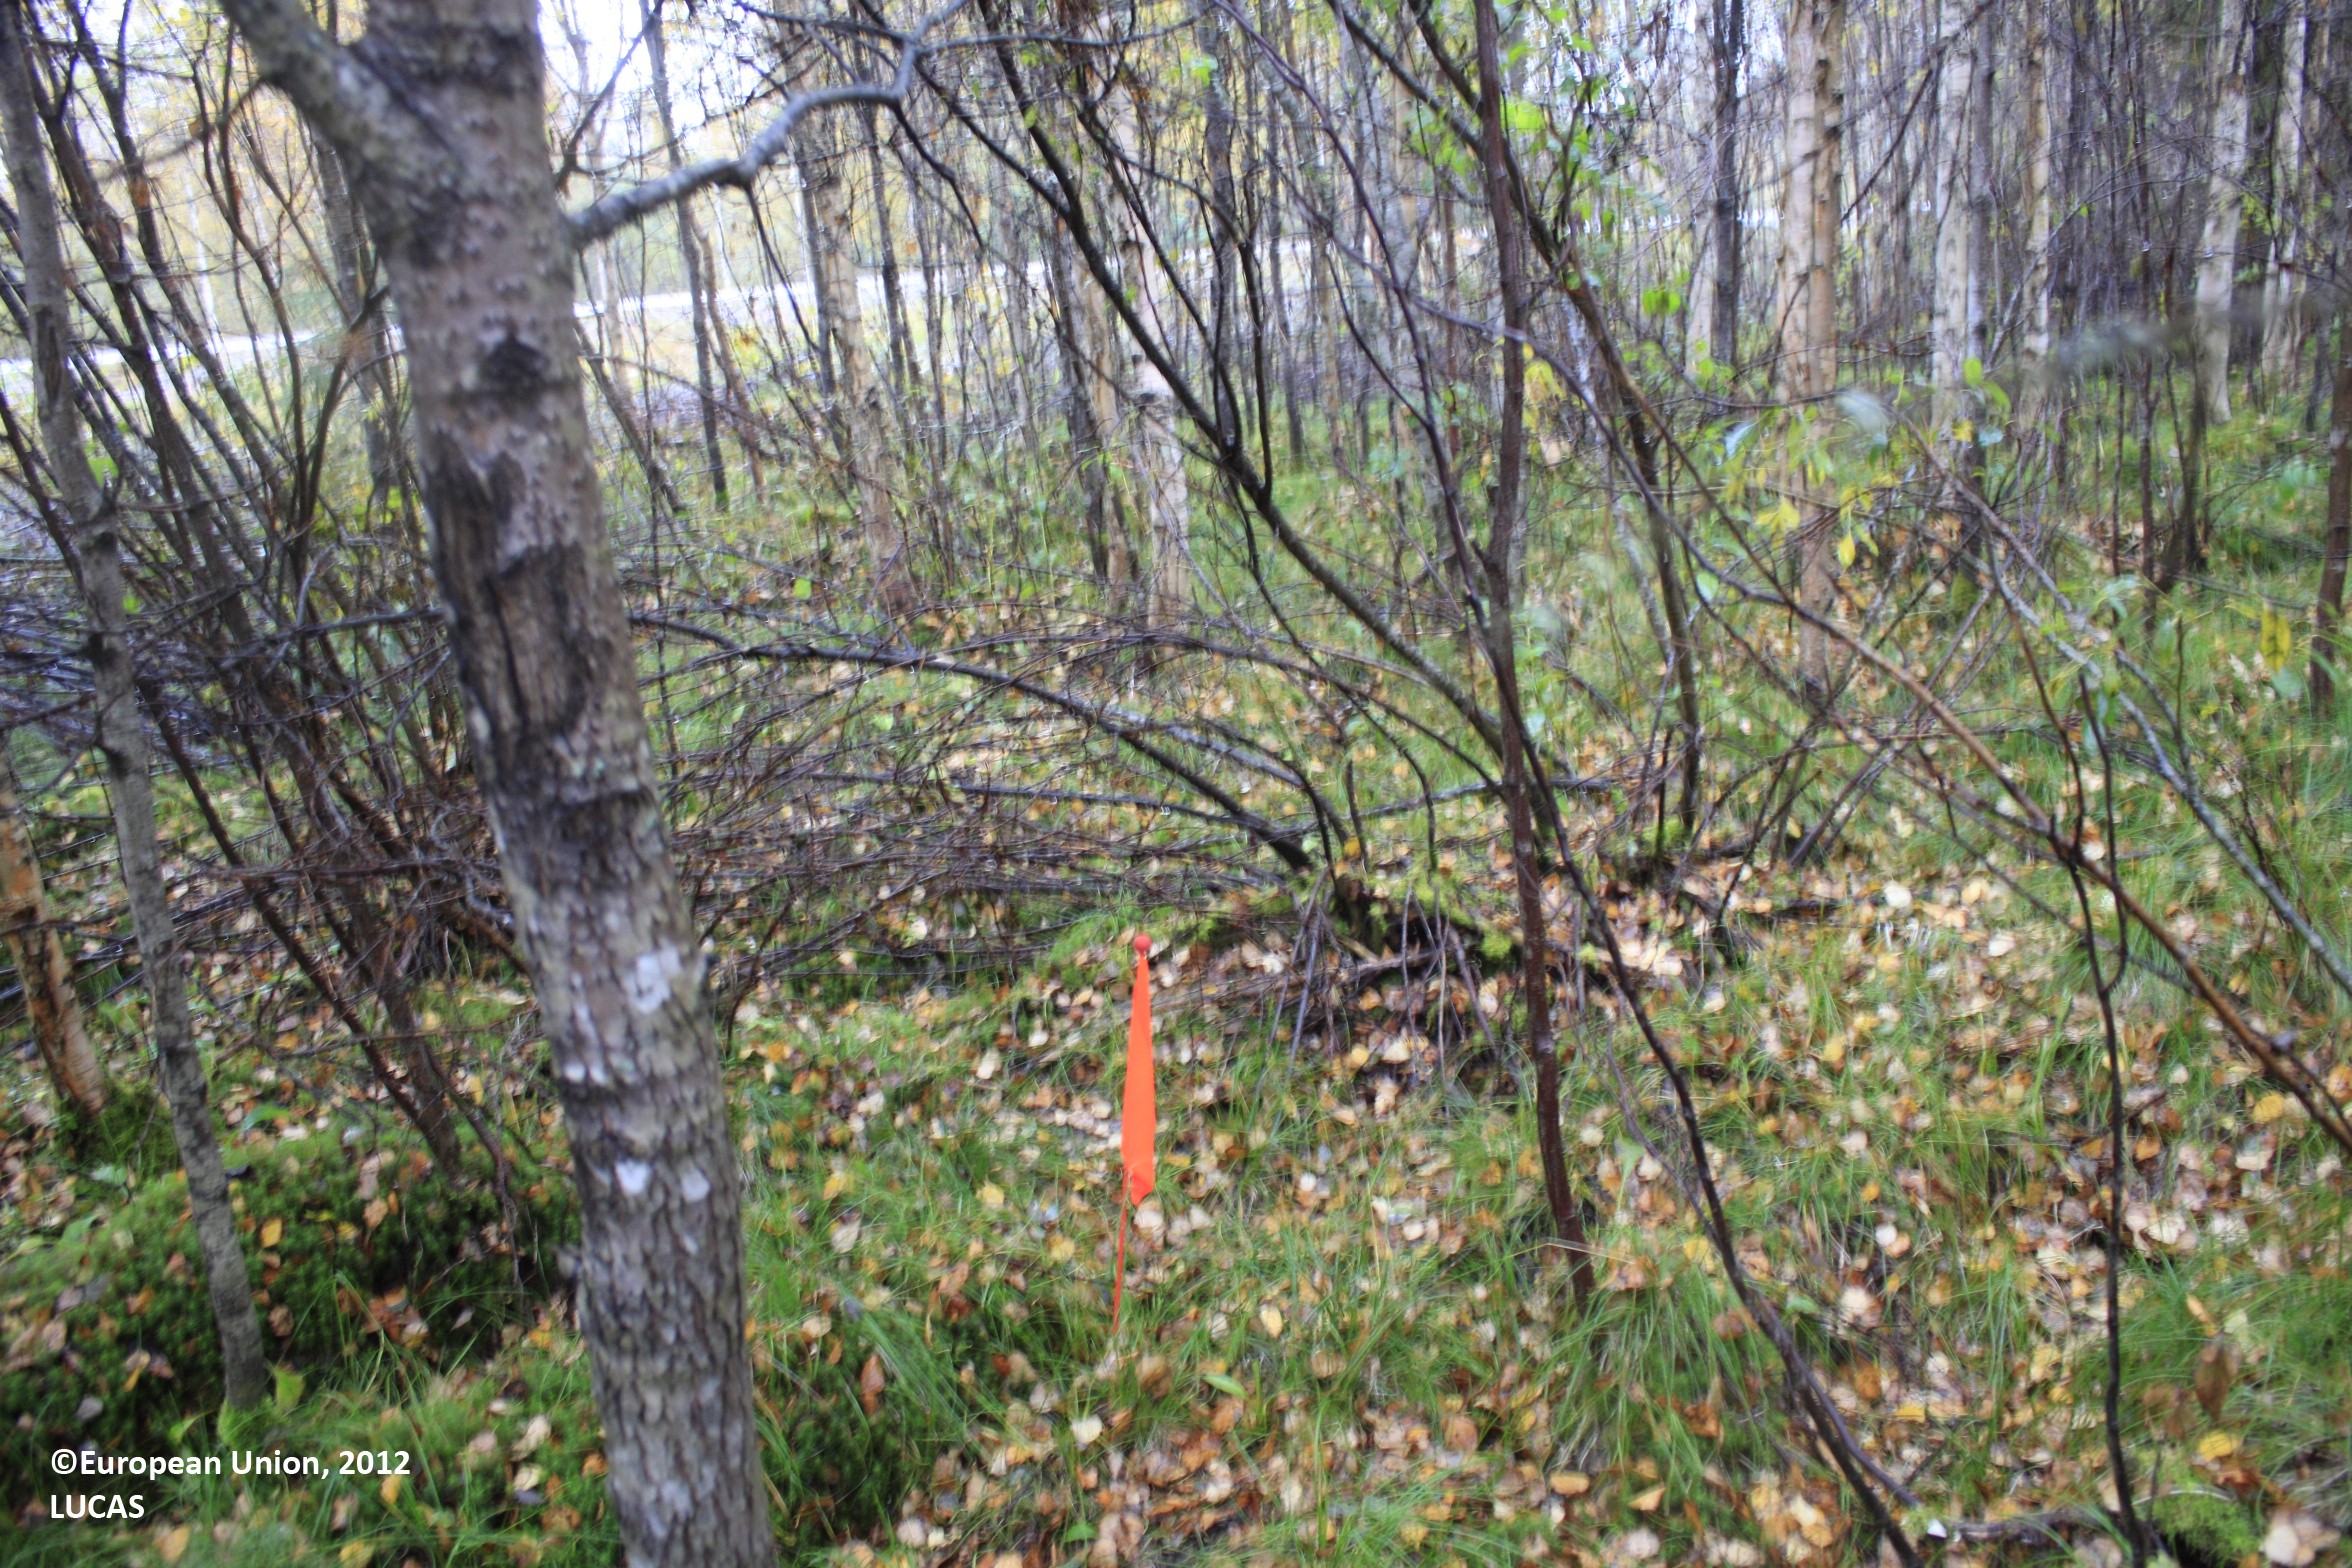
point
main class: Woodland
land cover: Broadleaved woodland
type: boreal forest
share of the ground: > 75 %
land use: Forestry
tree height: > 5 m
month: September
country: FI
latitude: 65.6406
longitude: 27.3981
